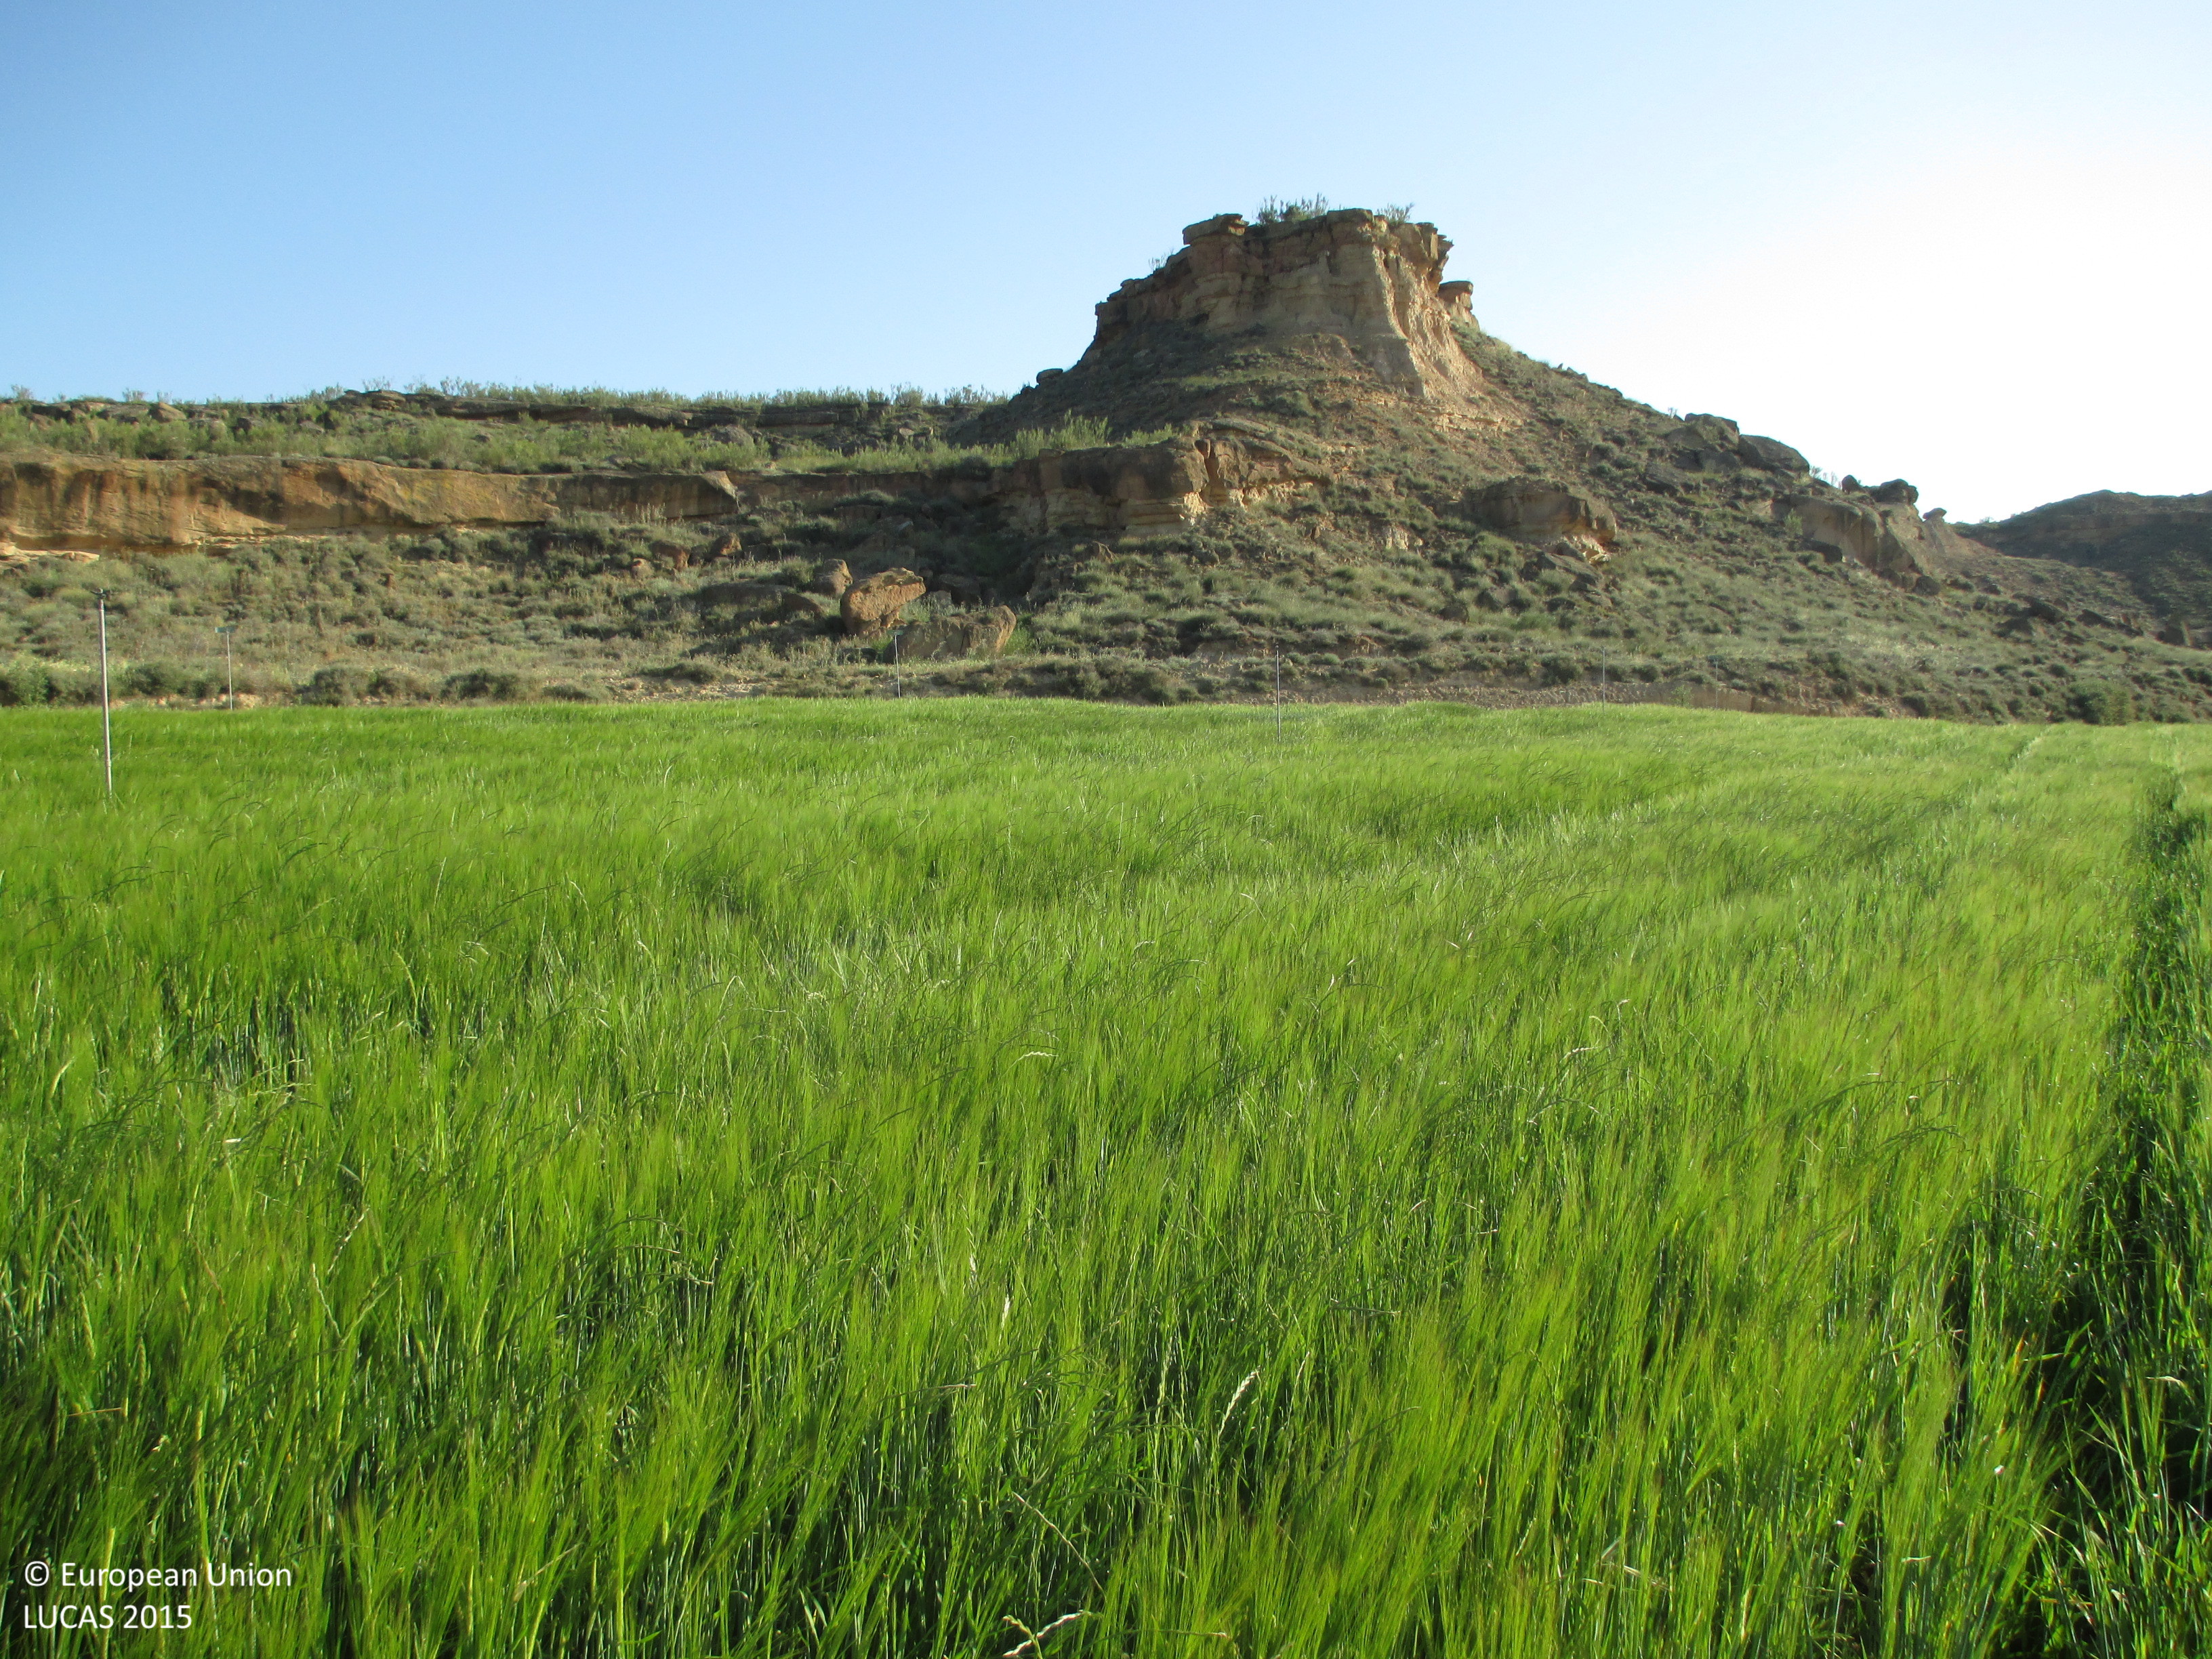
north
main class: Cropland
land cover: Barley
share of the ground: > 75 %
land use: Agriculture (excluding fallow land and kitchen gardens)
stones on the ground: < 10 %
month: May
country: ES
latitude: 41.9730
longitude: -0.3872
